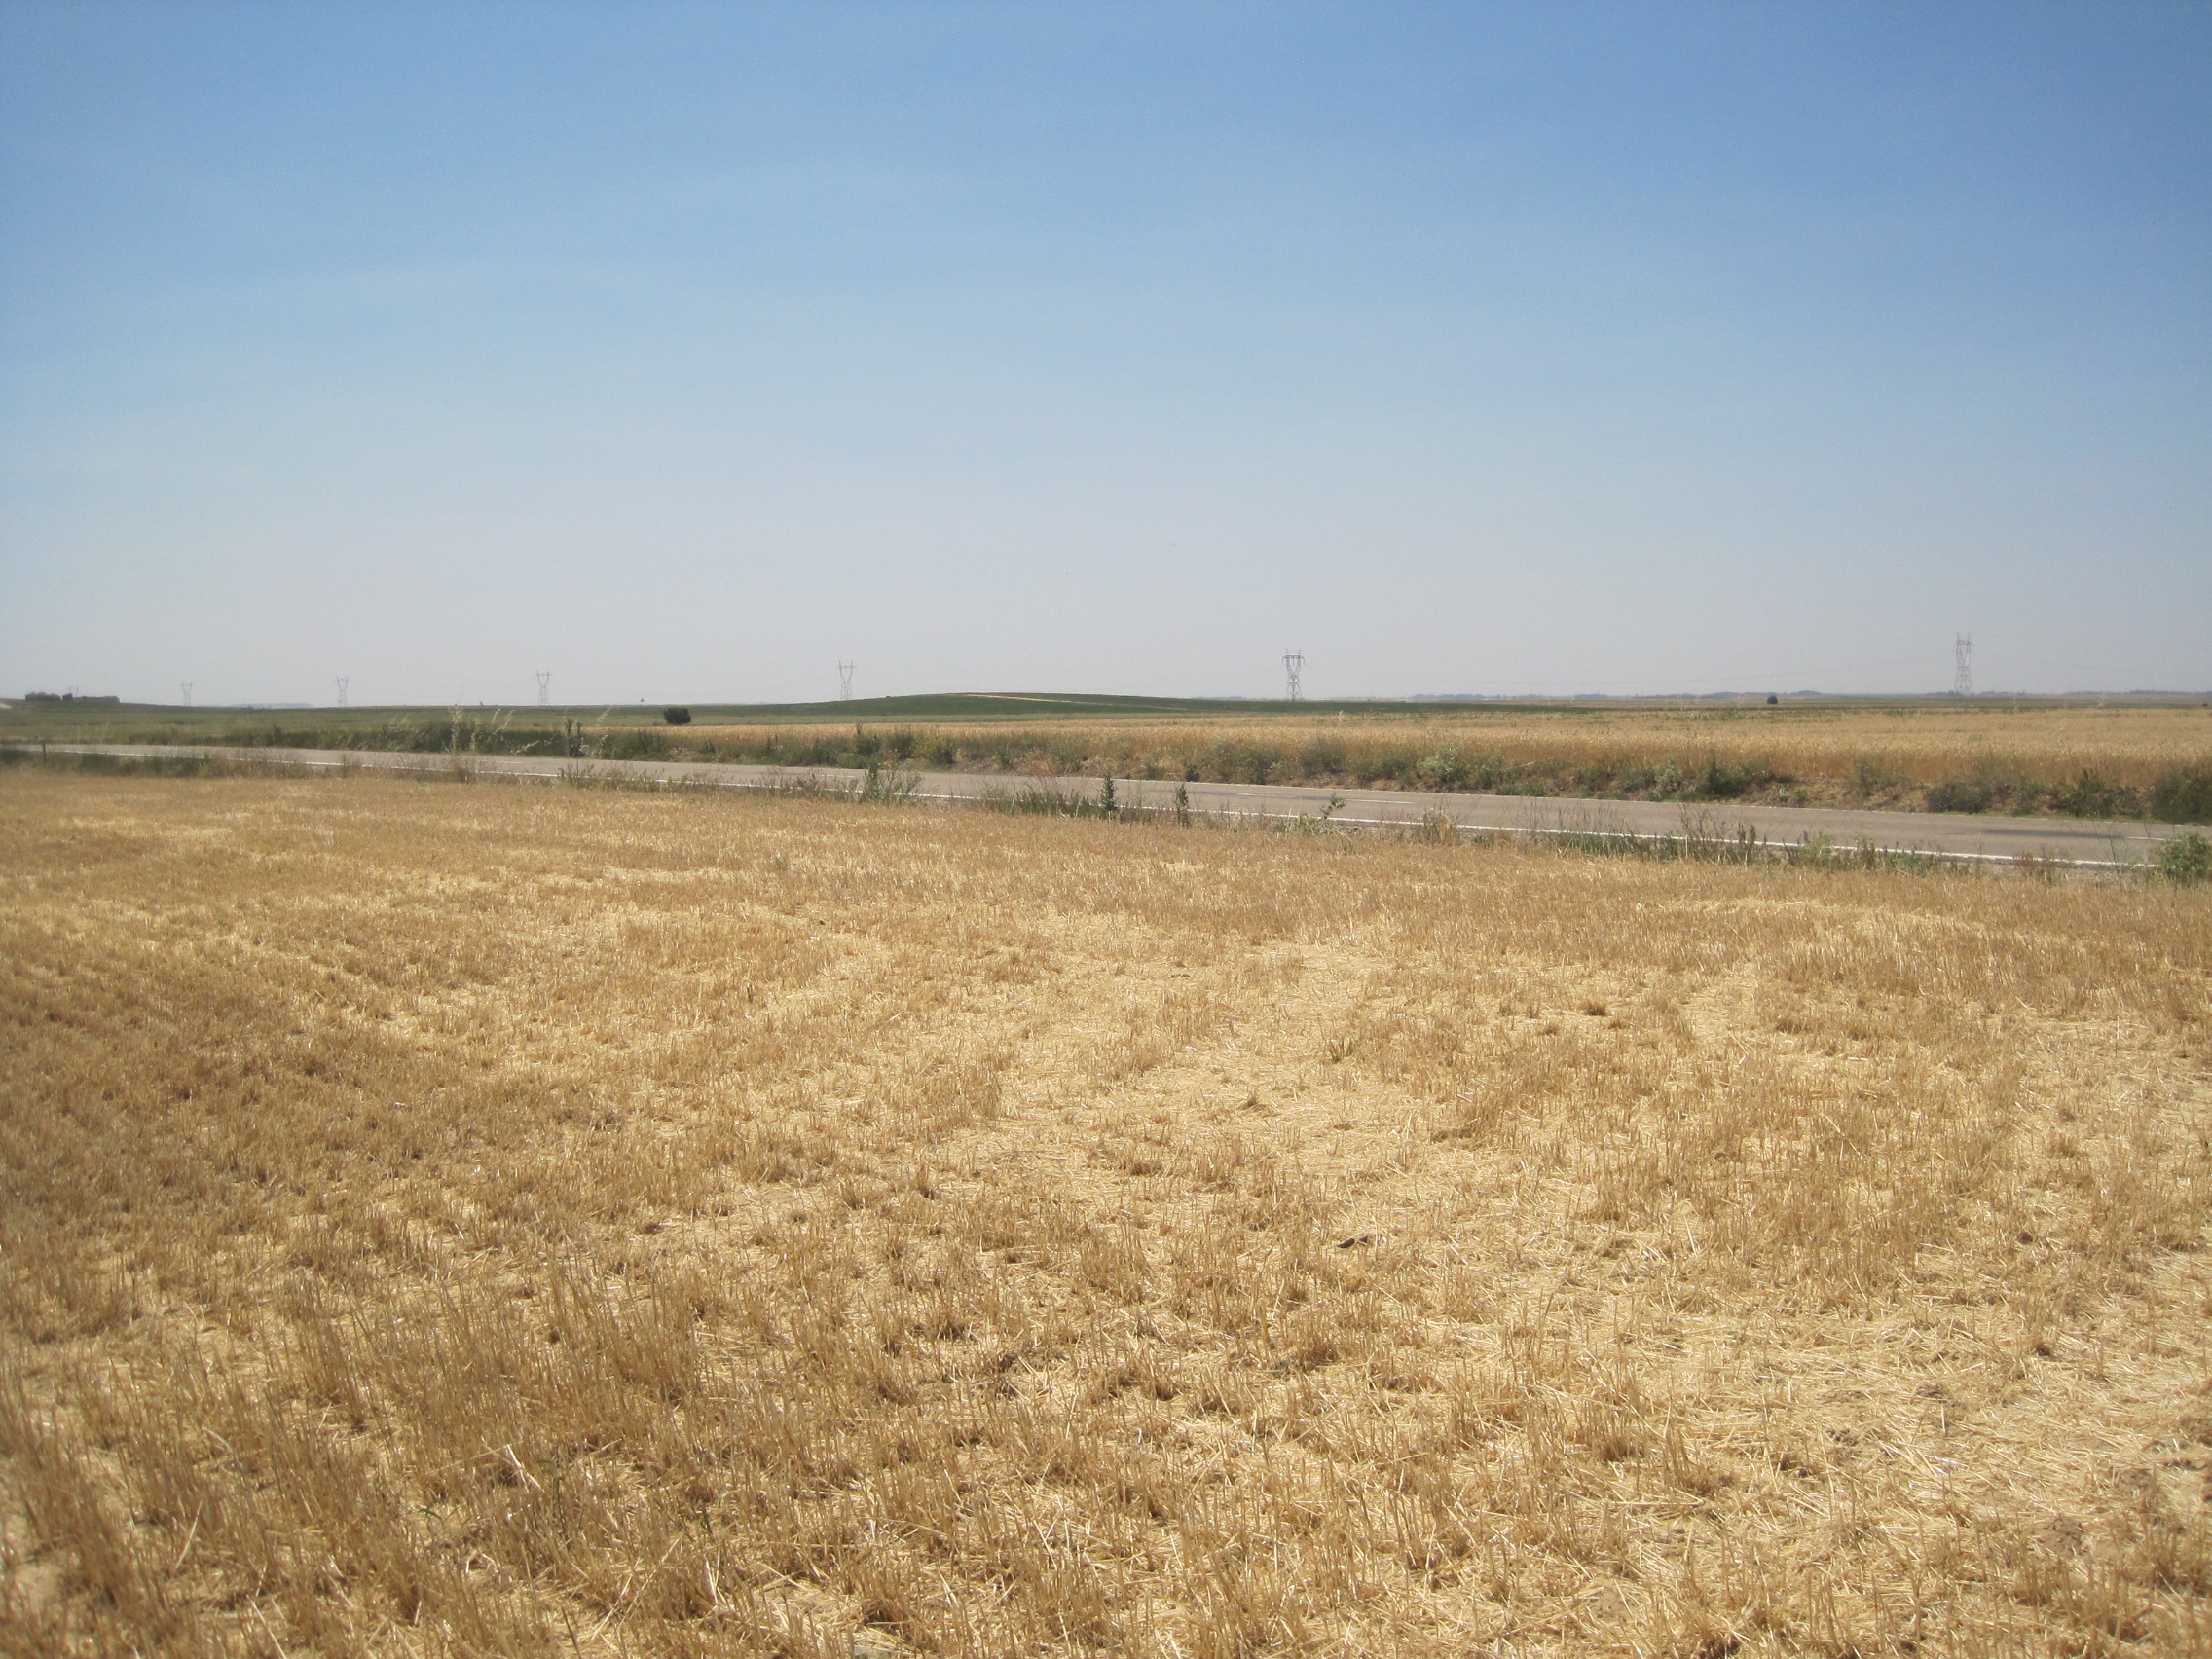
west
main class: Cropland
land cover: Barley
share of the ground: < 10 %
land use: Agriculture (excluding fallow land and kitchen gardens)
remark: Harvested field
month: July
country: ES
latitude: 41.9692
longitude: -4.7592
